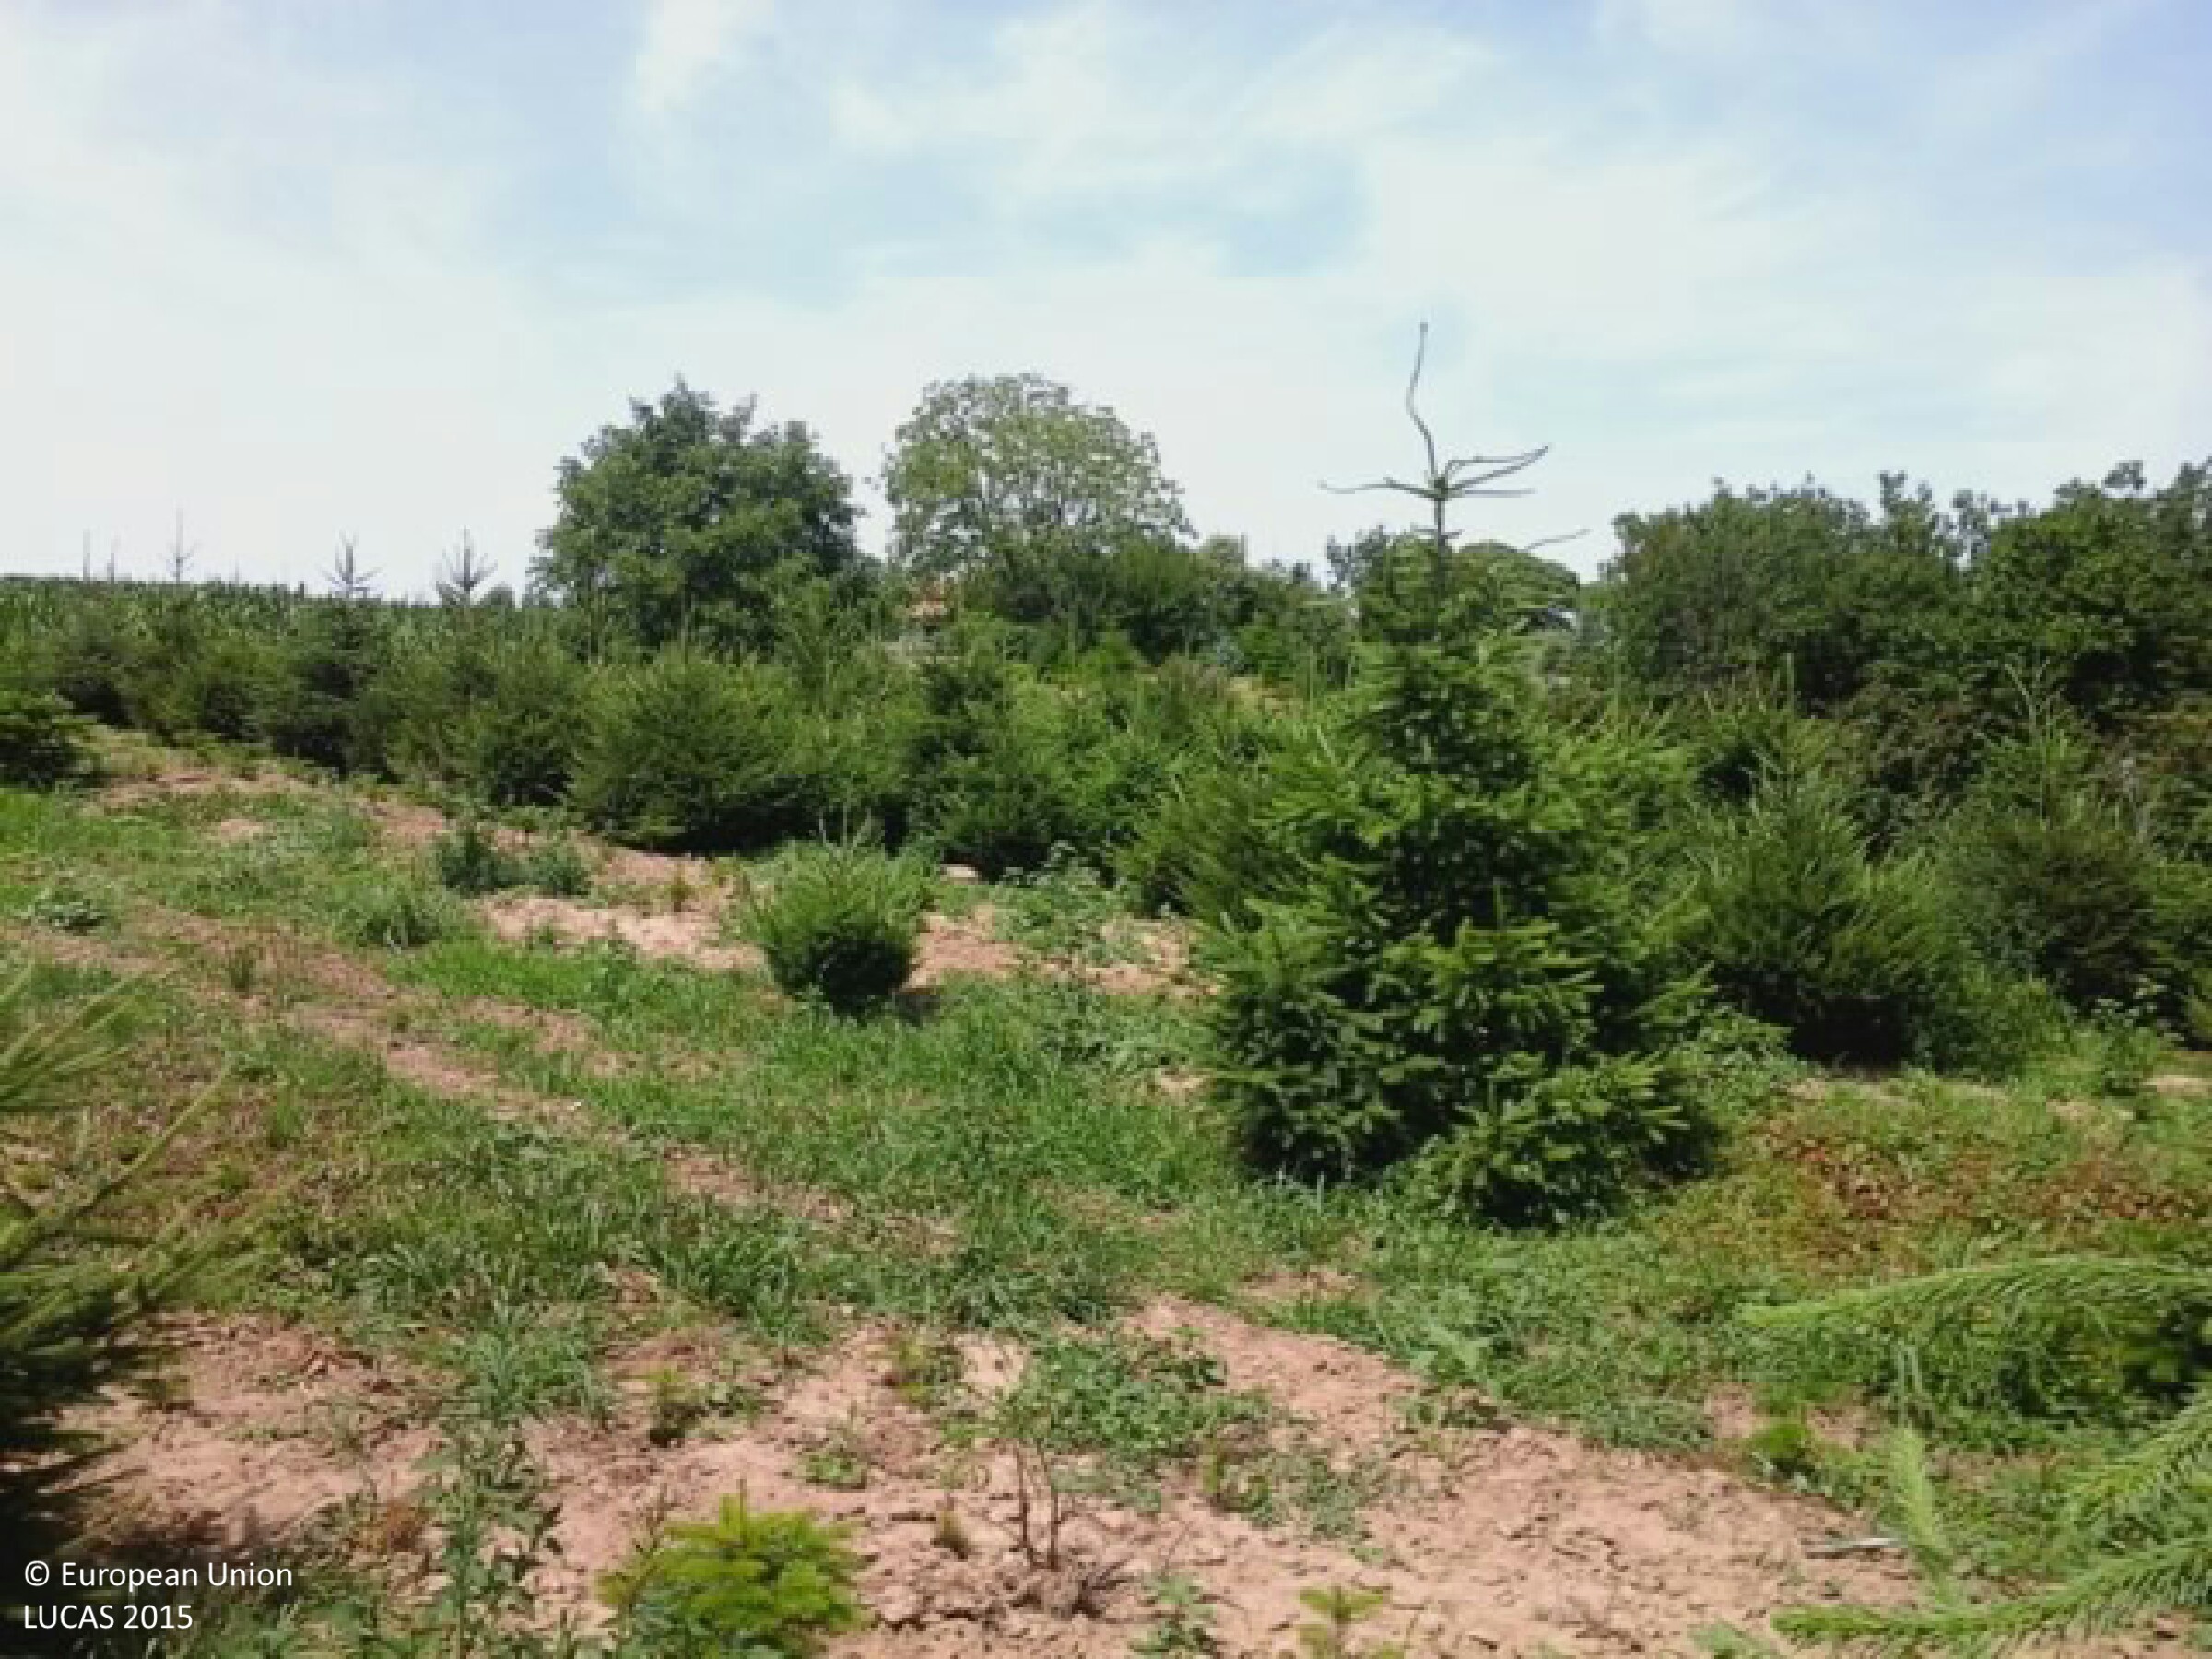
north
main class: Cropland
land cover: Nurseries
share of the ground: > 75 %
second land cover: Other bare soil
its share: > 75 %
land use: Agriculture (excluding fallow land and kitchen gardens)
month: June
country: HU
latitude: 46.4036
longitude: 17.3792
